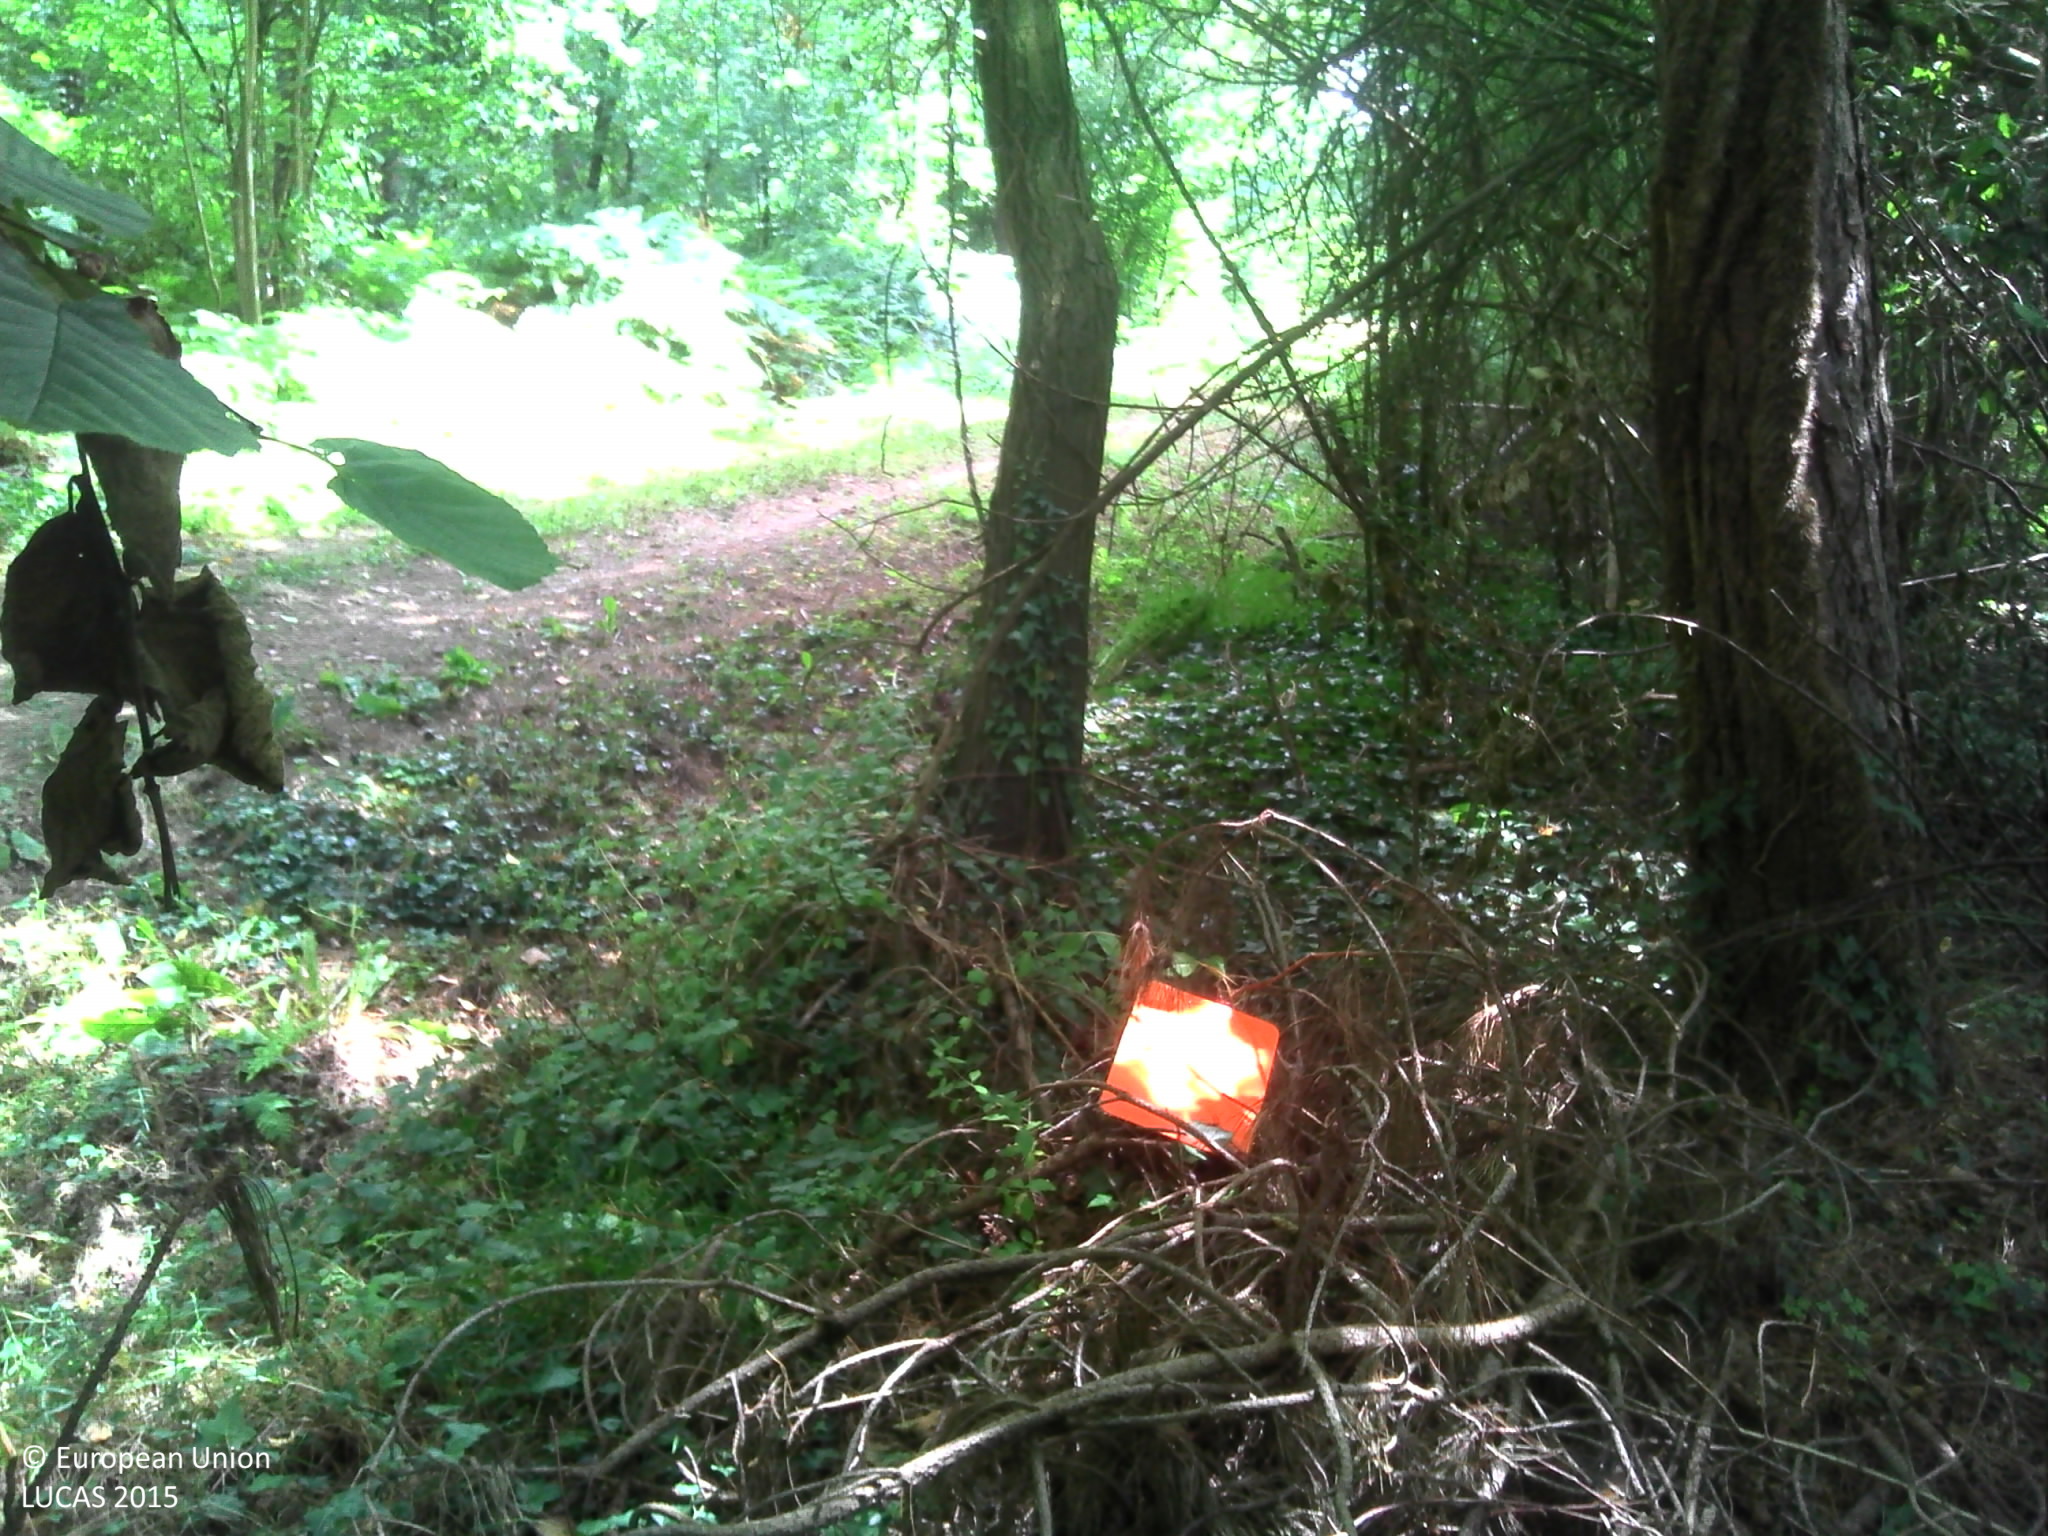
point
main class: Woodland
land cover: Broadleaved woodland
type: mesophytic deciduous forest
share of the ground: > 75 %
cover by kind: broadleaved forest trees 95 %, coniferous forest trees 5 %
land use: Forestry
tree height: > 5 m
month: August
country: FR
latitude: 46.7794
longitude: -1.3669
